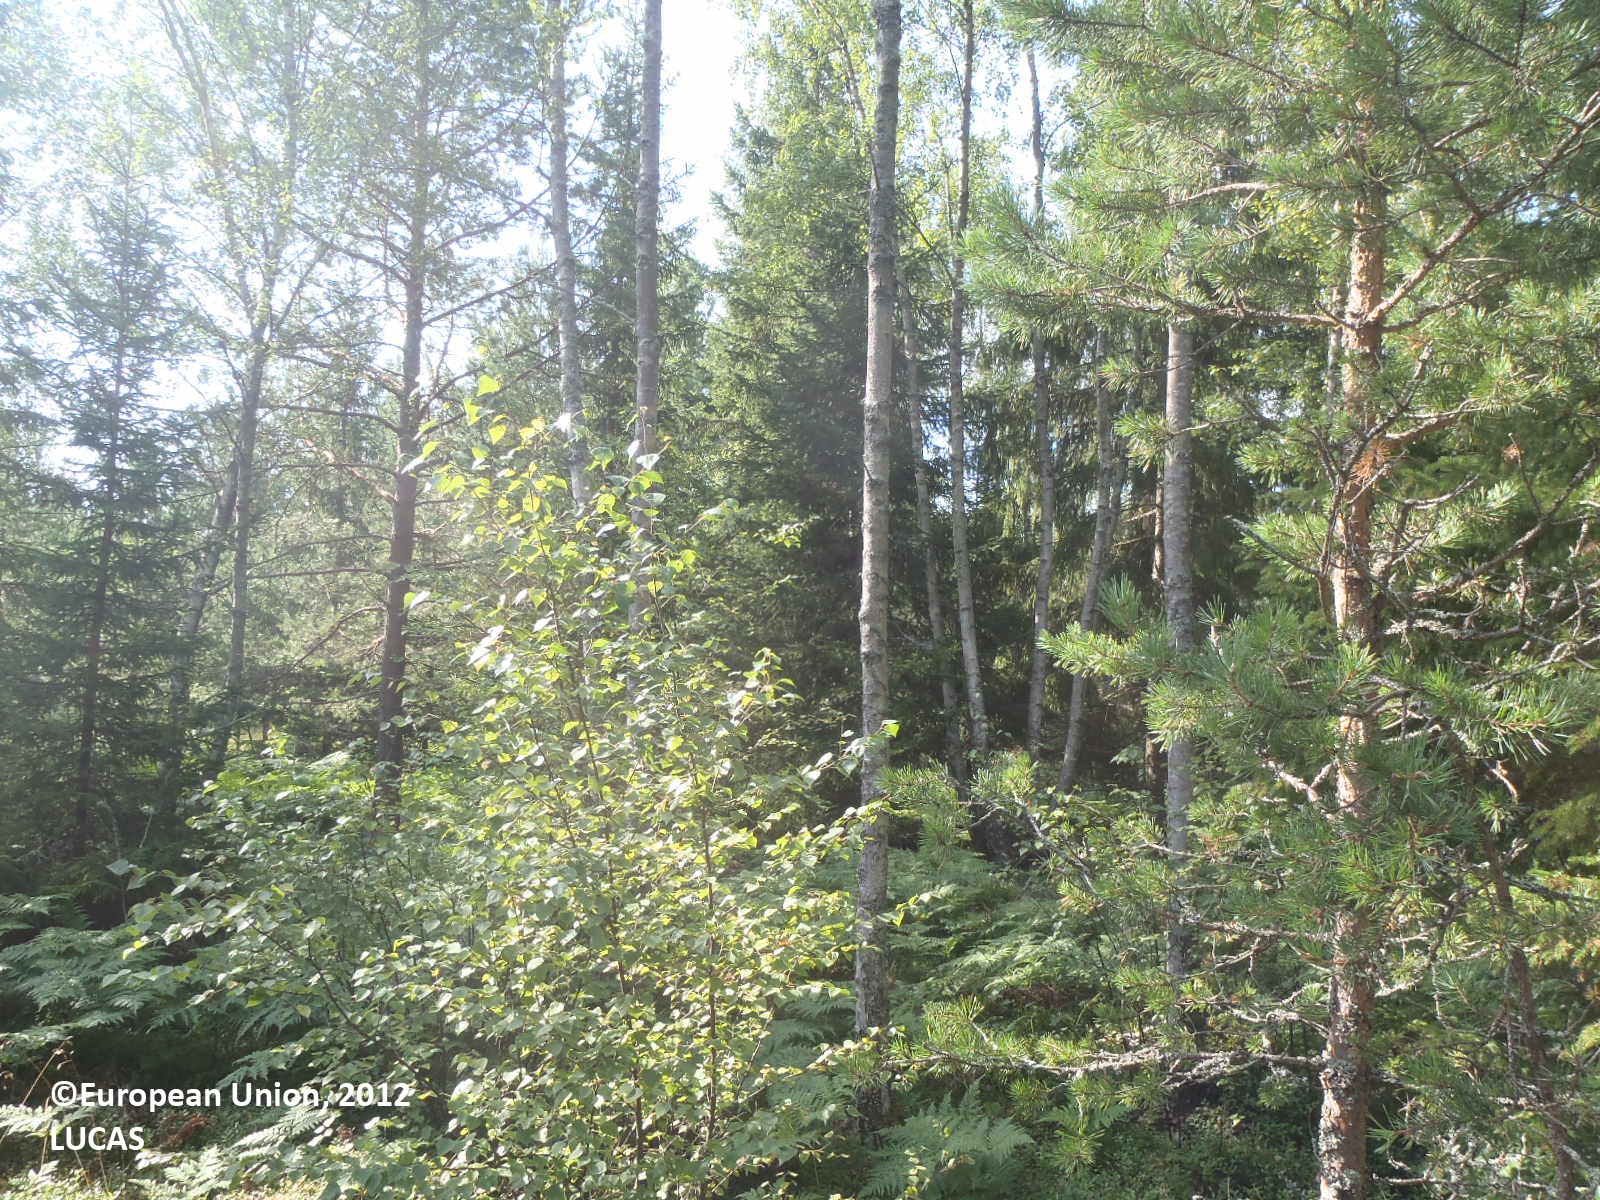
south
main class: Woodland
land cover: Pine dominated mixed woodland
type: hemiboreal forest and nemoral coniferous forest and mixed broadleaved-coniferous forest
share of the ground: 50 - 75 %
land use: Forestry
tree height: > 5 m
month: August
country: FI
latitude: 60.1867
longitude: 20.2694
